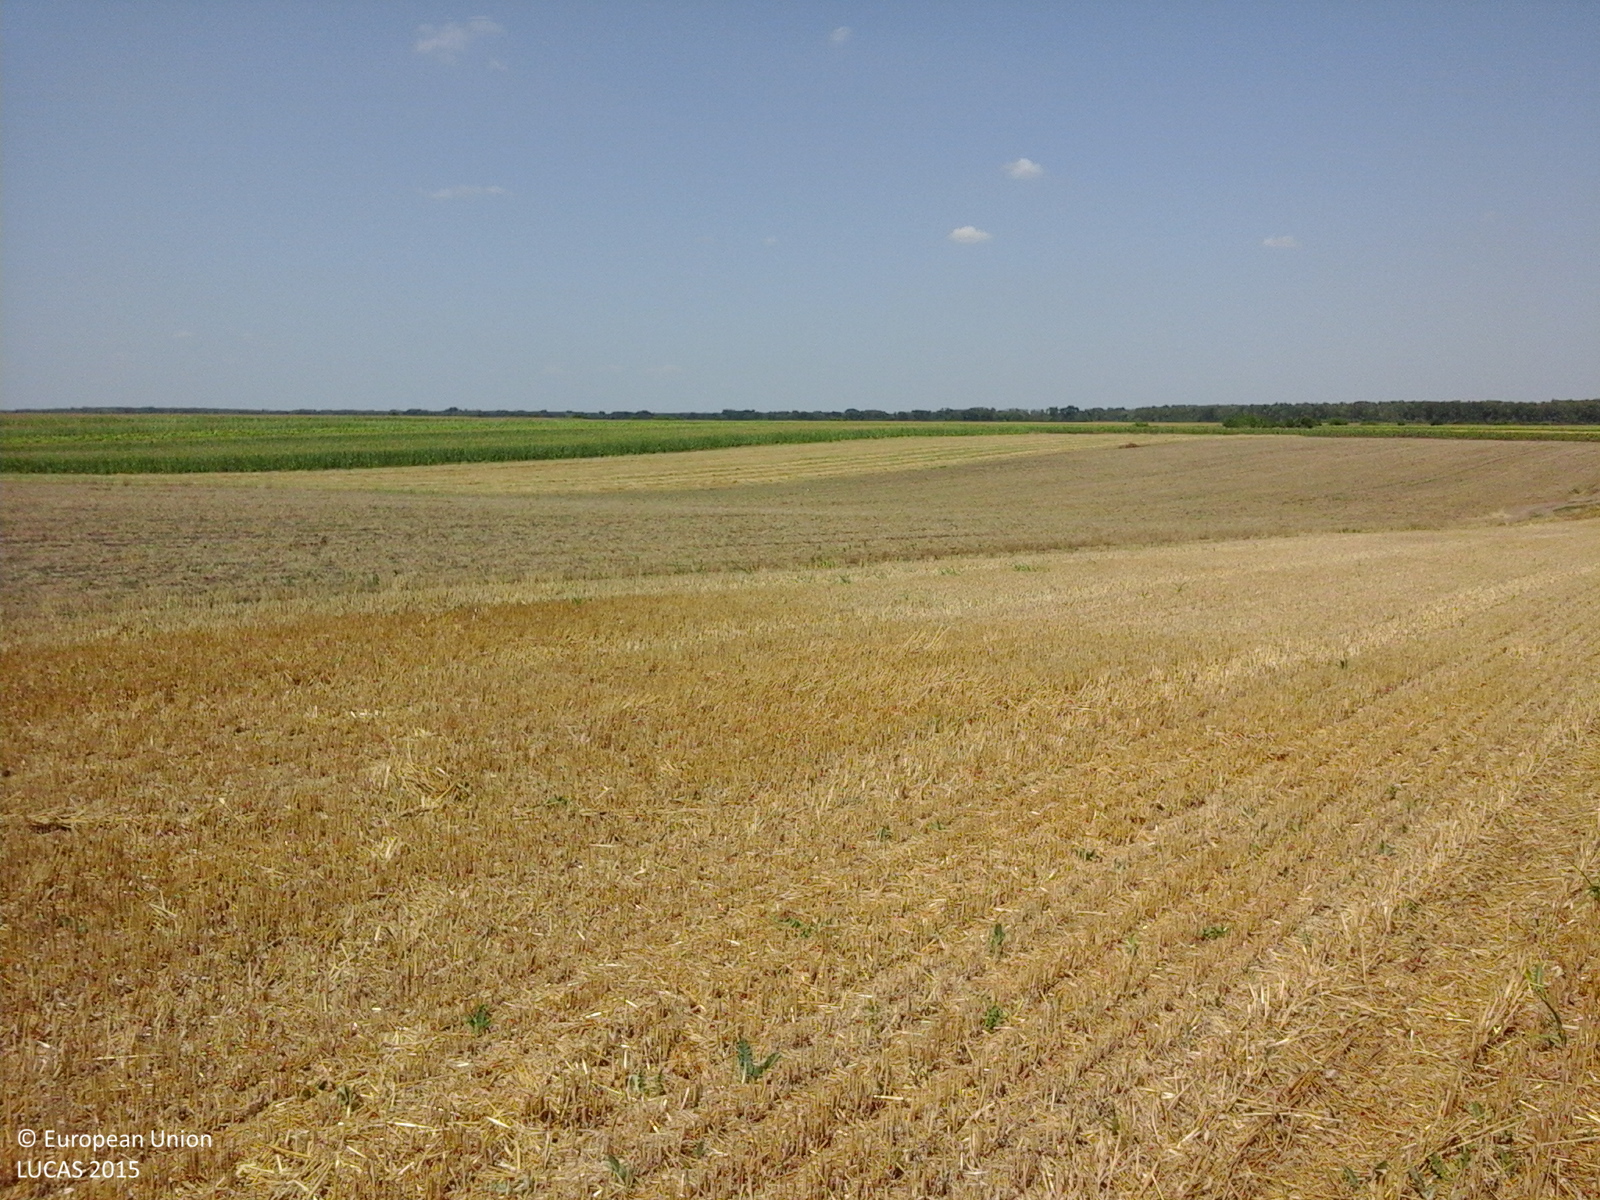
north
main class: Cropland
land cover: Common wheat
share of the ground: 50 - 75 %
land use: Agriculture (excluding fallow land and kitchen gardens)
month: July
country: RO
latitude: 44.2294
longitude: 26.9632
